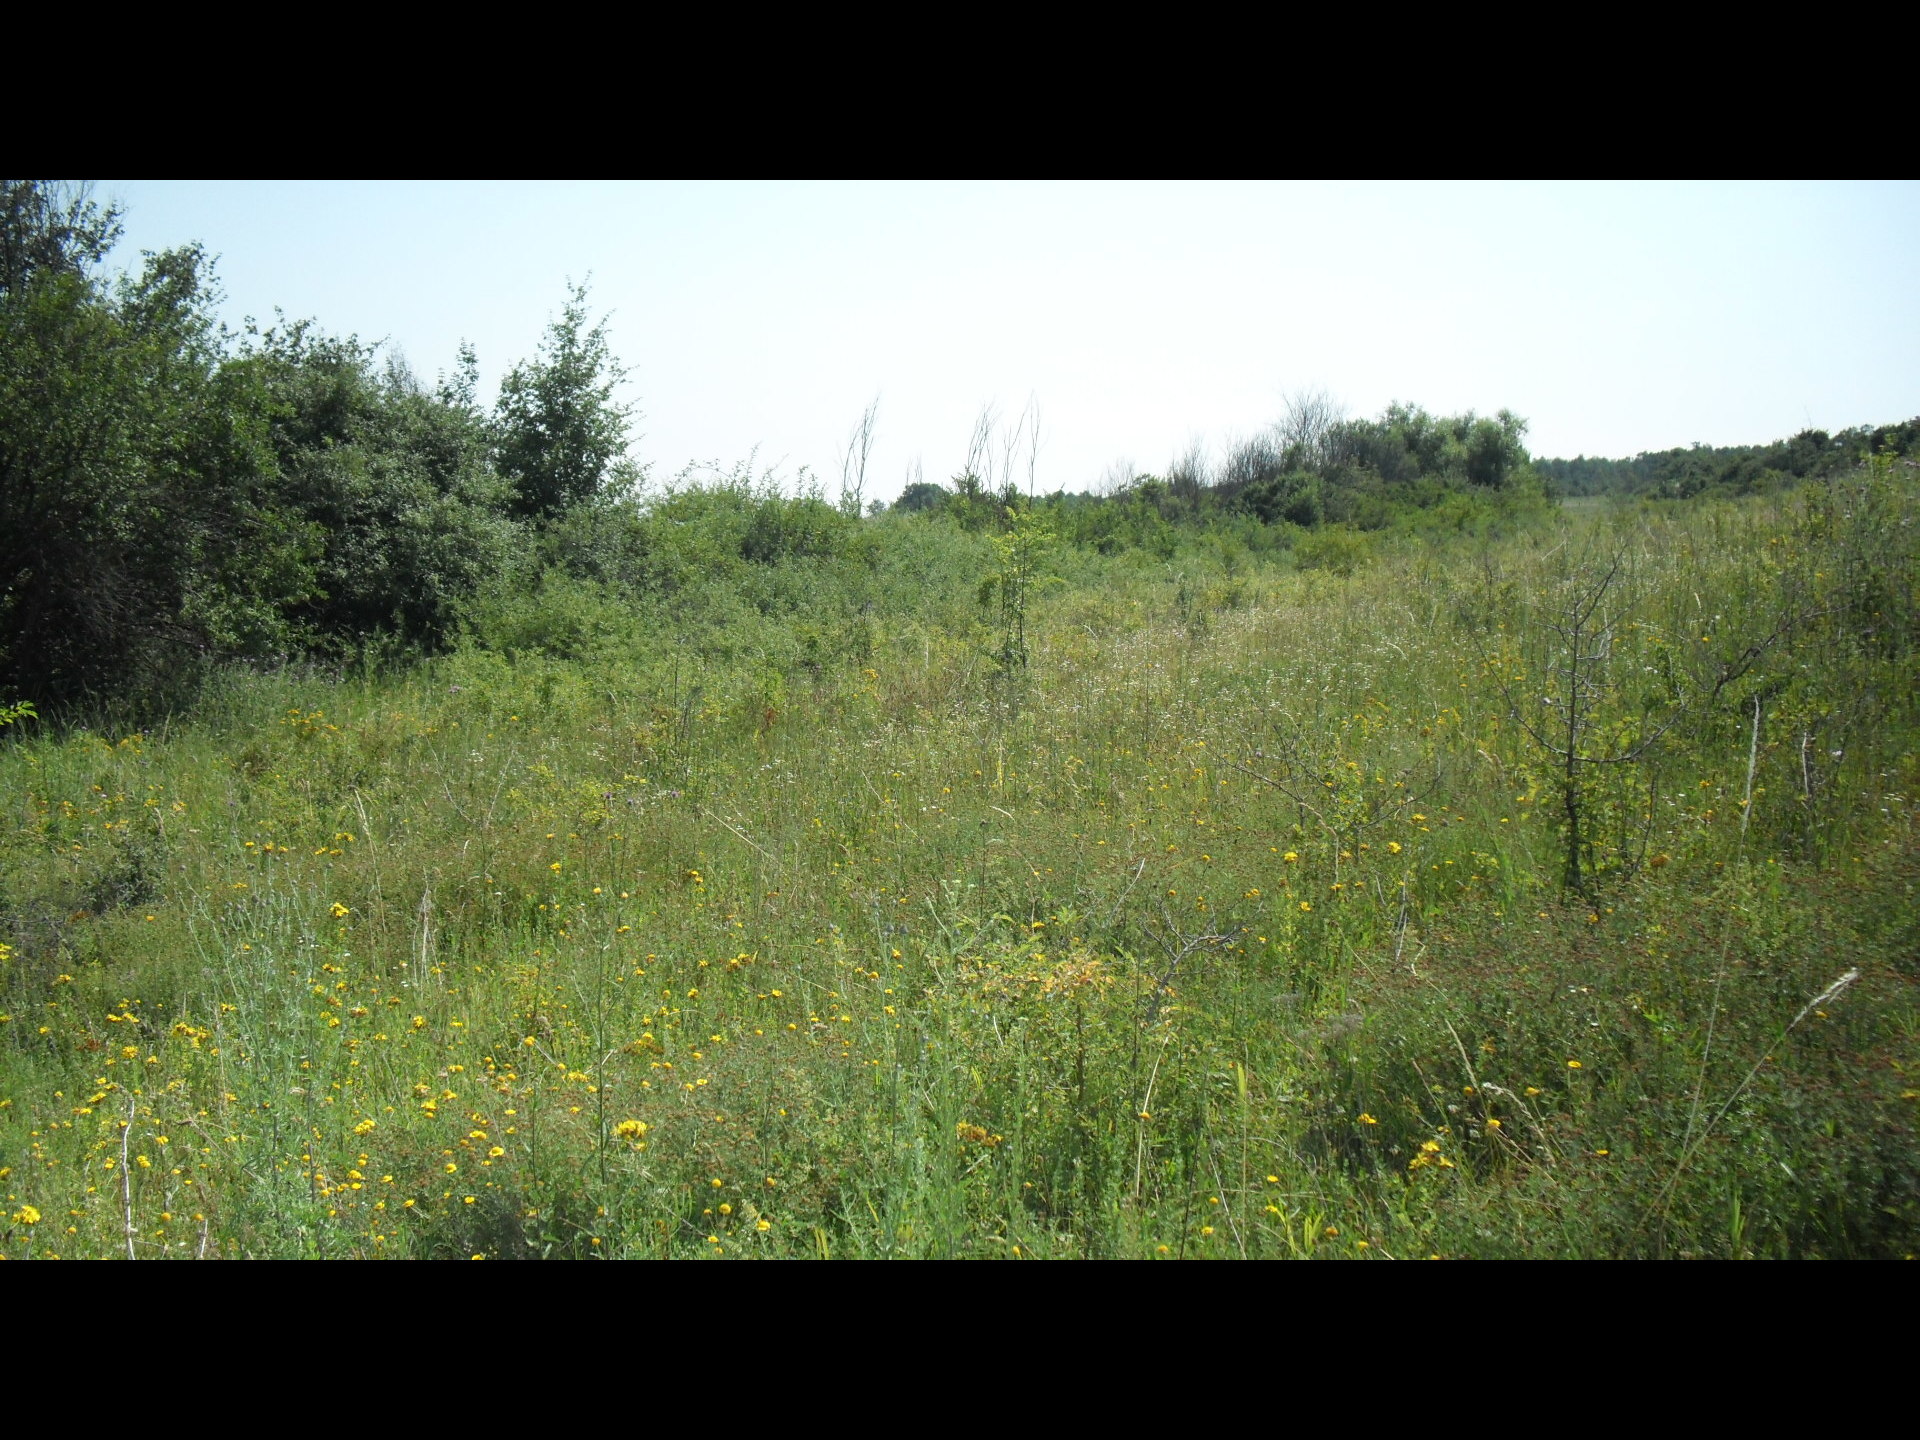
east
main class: Grassland
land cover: Grassland with sparse tree/shrub cover
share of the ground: > 75 %
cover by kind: herbaceous plants 90 %, broadleaved forest trees 5 %, shrubs 5 %
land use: Semi-natural and natural areas not in use
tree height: < 5 m
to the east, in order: Grassland with sparse tree/shrub cover; Shrubland with sparse tree cover; Tracks; Spontaneously vegetated surfaces
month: July
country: BG
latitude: 43.8030
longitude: 22.8528
